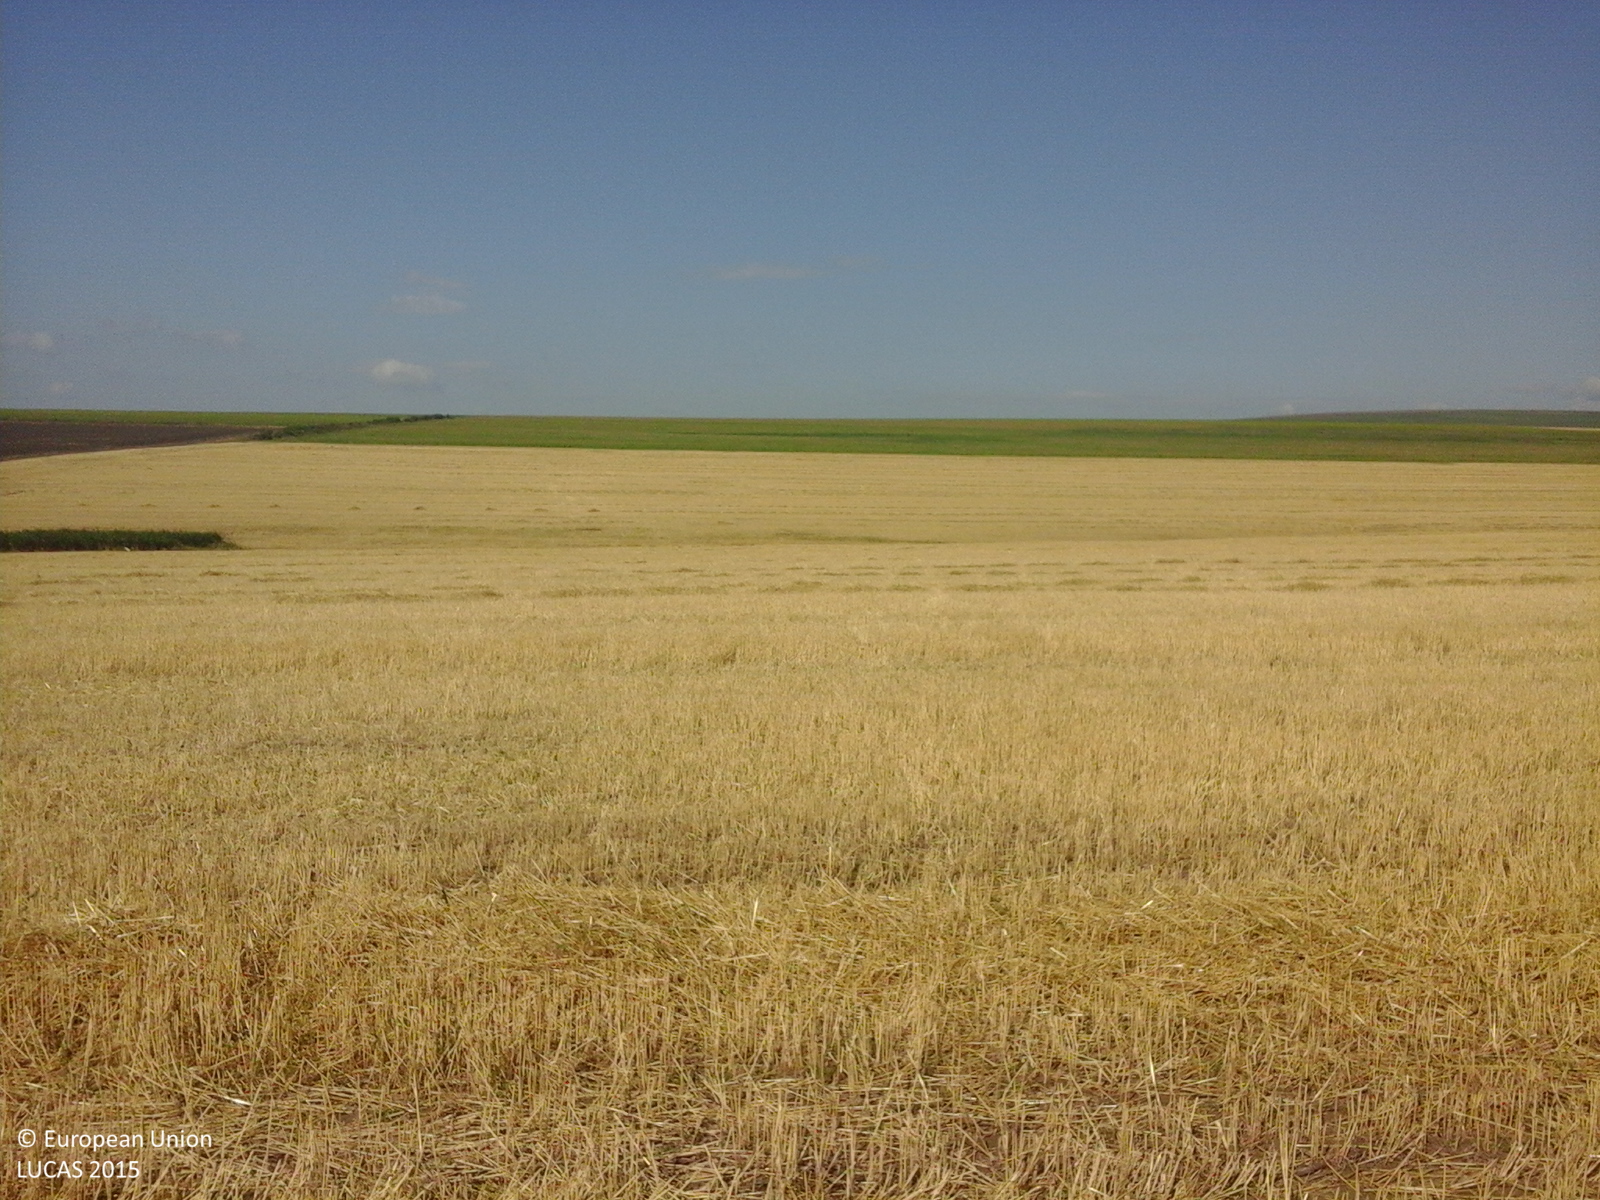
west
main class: Cropland
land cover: Common wheat
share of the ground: > 75 %
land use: Agriculture (excluding fallow land and kitchen gardens)
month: July
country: RO
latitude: 46.3747
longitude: 28.1085
